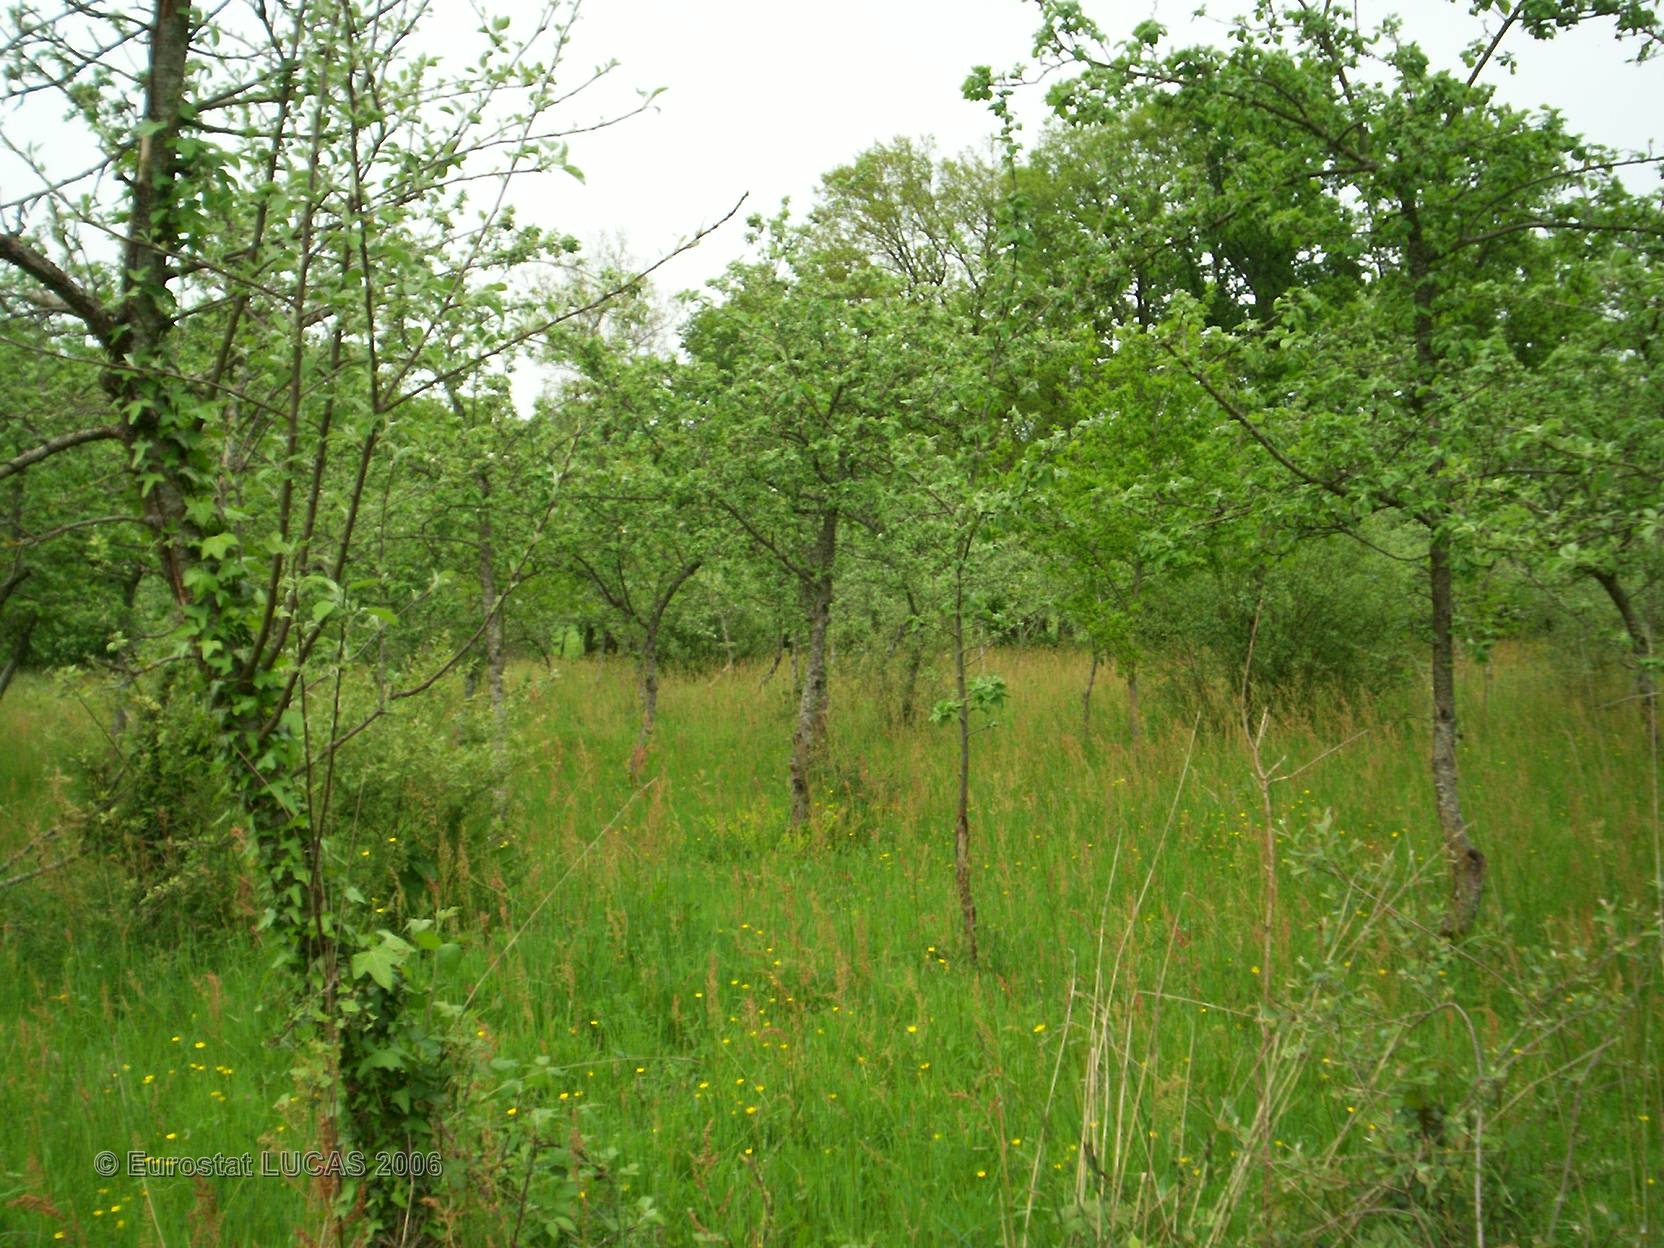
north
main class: Cropland
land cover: Apple fruit
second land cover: Grassland with sparse tree/shrub cover
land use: Agriculture (excluding fallow land and kitchen gardens)
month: May
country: FR
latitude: 48.3116
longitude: -1.6581
